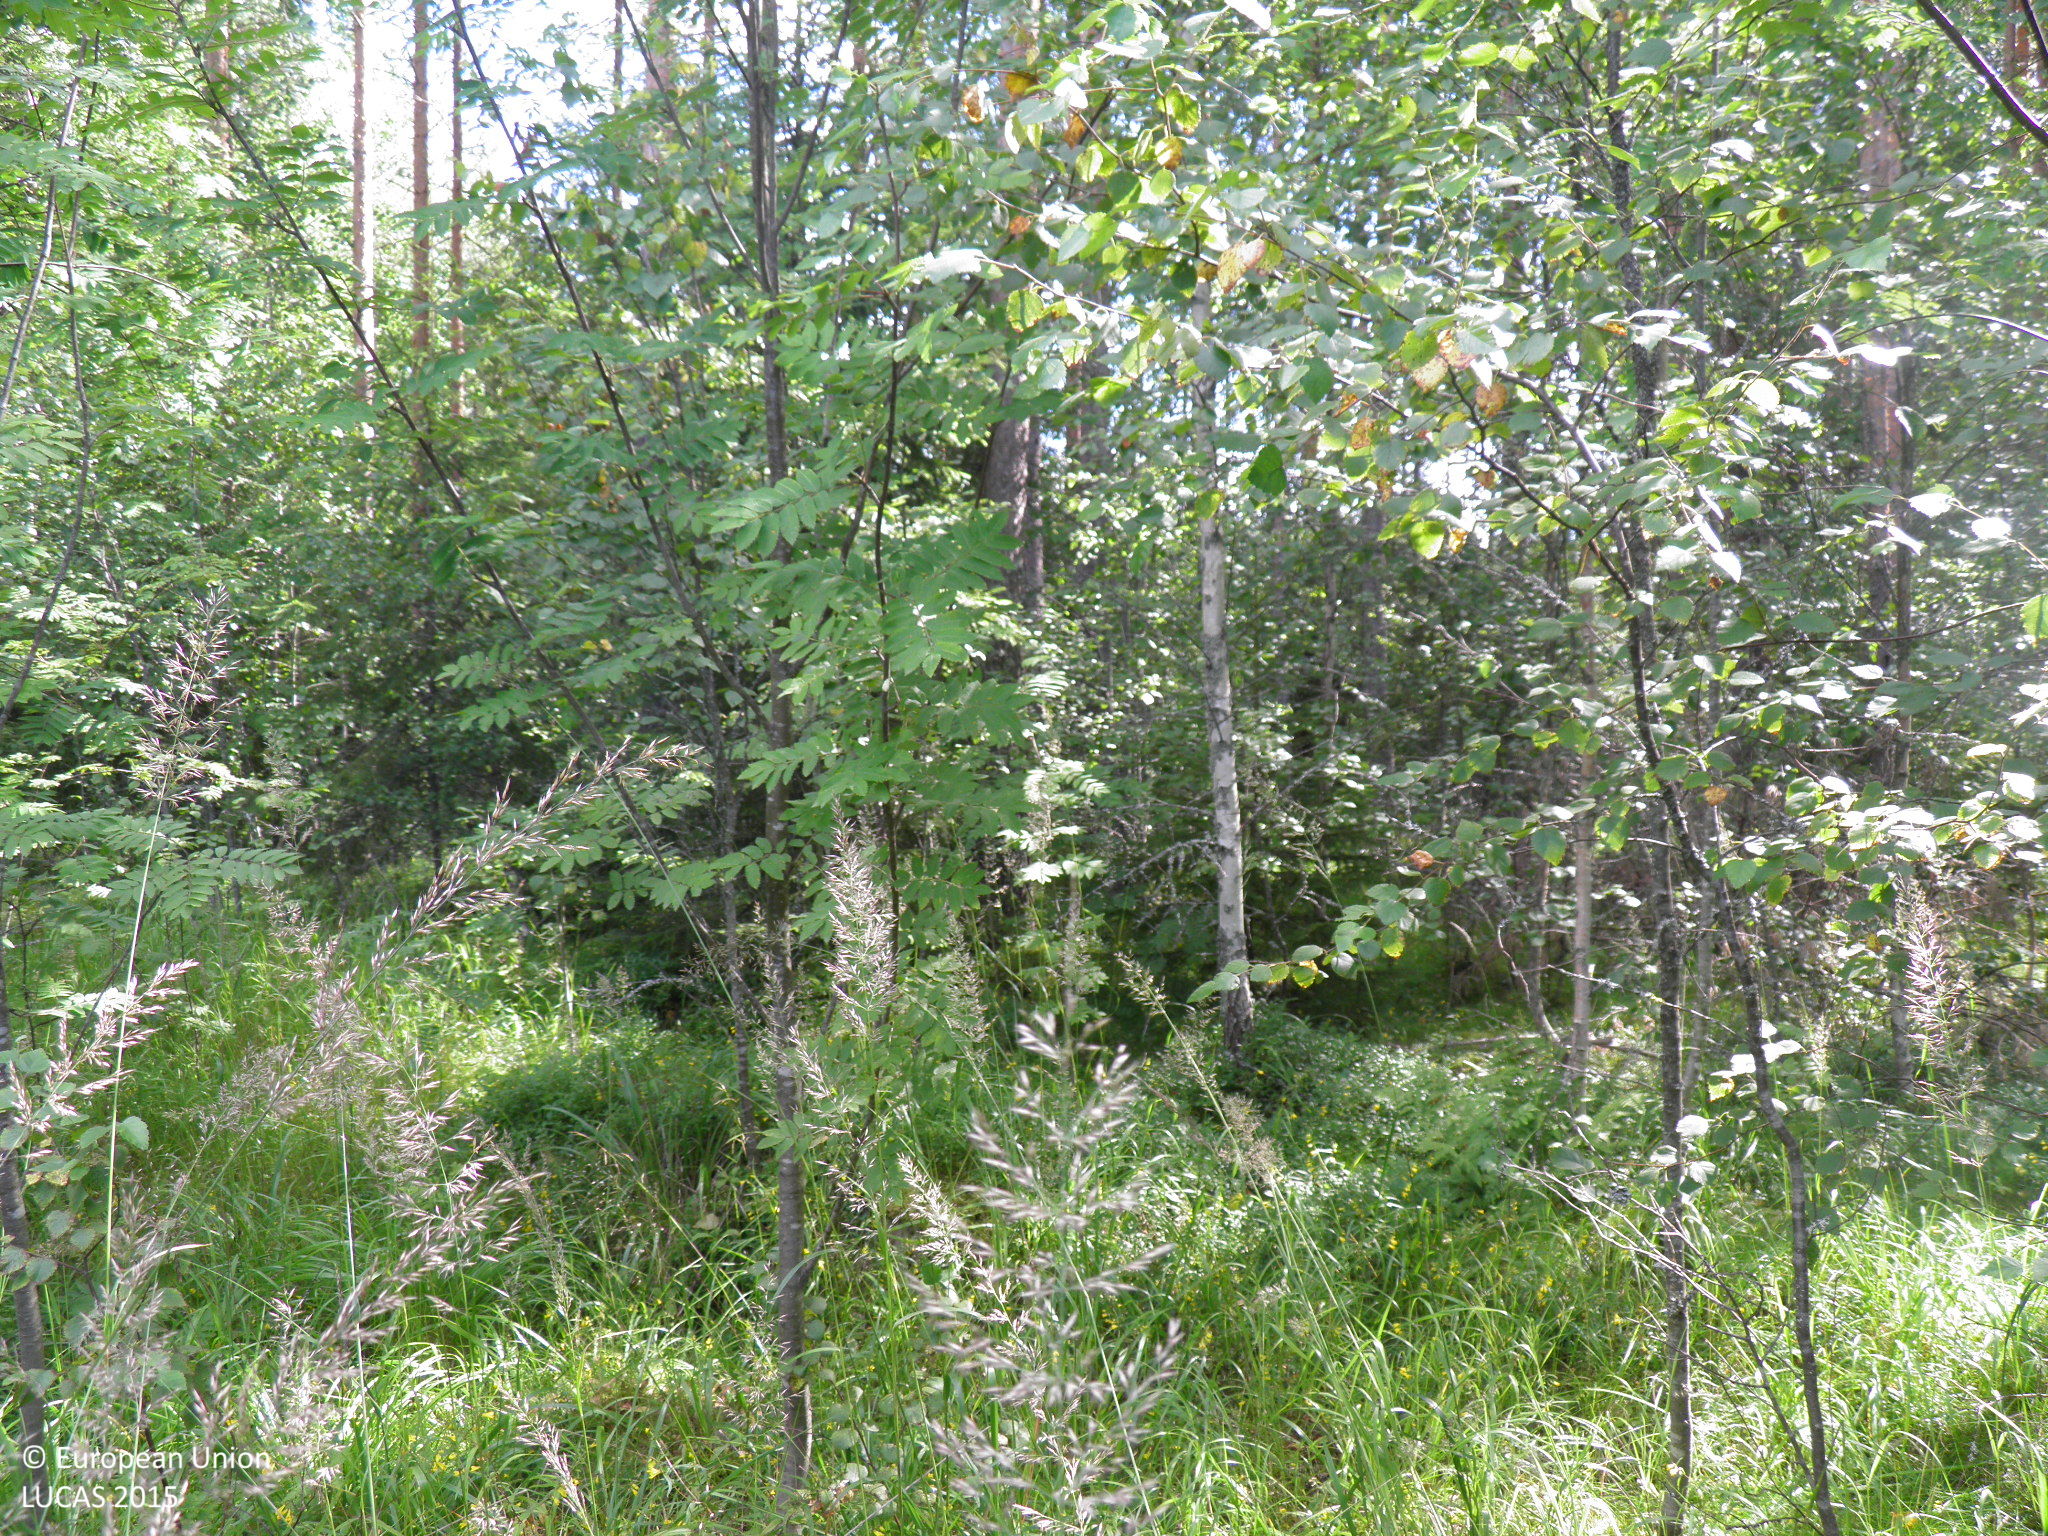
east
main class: Woodland
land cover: Pine dominated mixed woodland
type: hemiboreal forest and nemoral coniferous forest and mixed broadleaved-coniferous forest
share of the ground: 50 - 75 %
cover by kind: coniferous forest trees 40 %, broadleaved forest trees 30 %, shrubs 15 %, herbaceous plants 15 %
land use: Forestry
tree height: > 5 m
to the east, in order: Pine dominated mixed woodland; Broadleaved woodland; Ditches and canals; Grass margins; Paved roads, cycling and walking lanes; Grass margins; Ditches and canals; Grass margins; Oats; Grass margins; Abandoned hedges; Ditches and canals; Spontaneously vegetated surfaces; Ditches and canals; Spruce dominated coniferous woodland; Tracks; Spruce dominated coniferous woodland
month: August
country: FI
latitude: 60.9736
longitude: 22.5011
